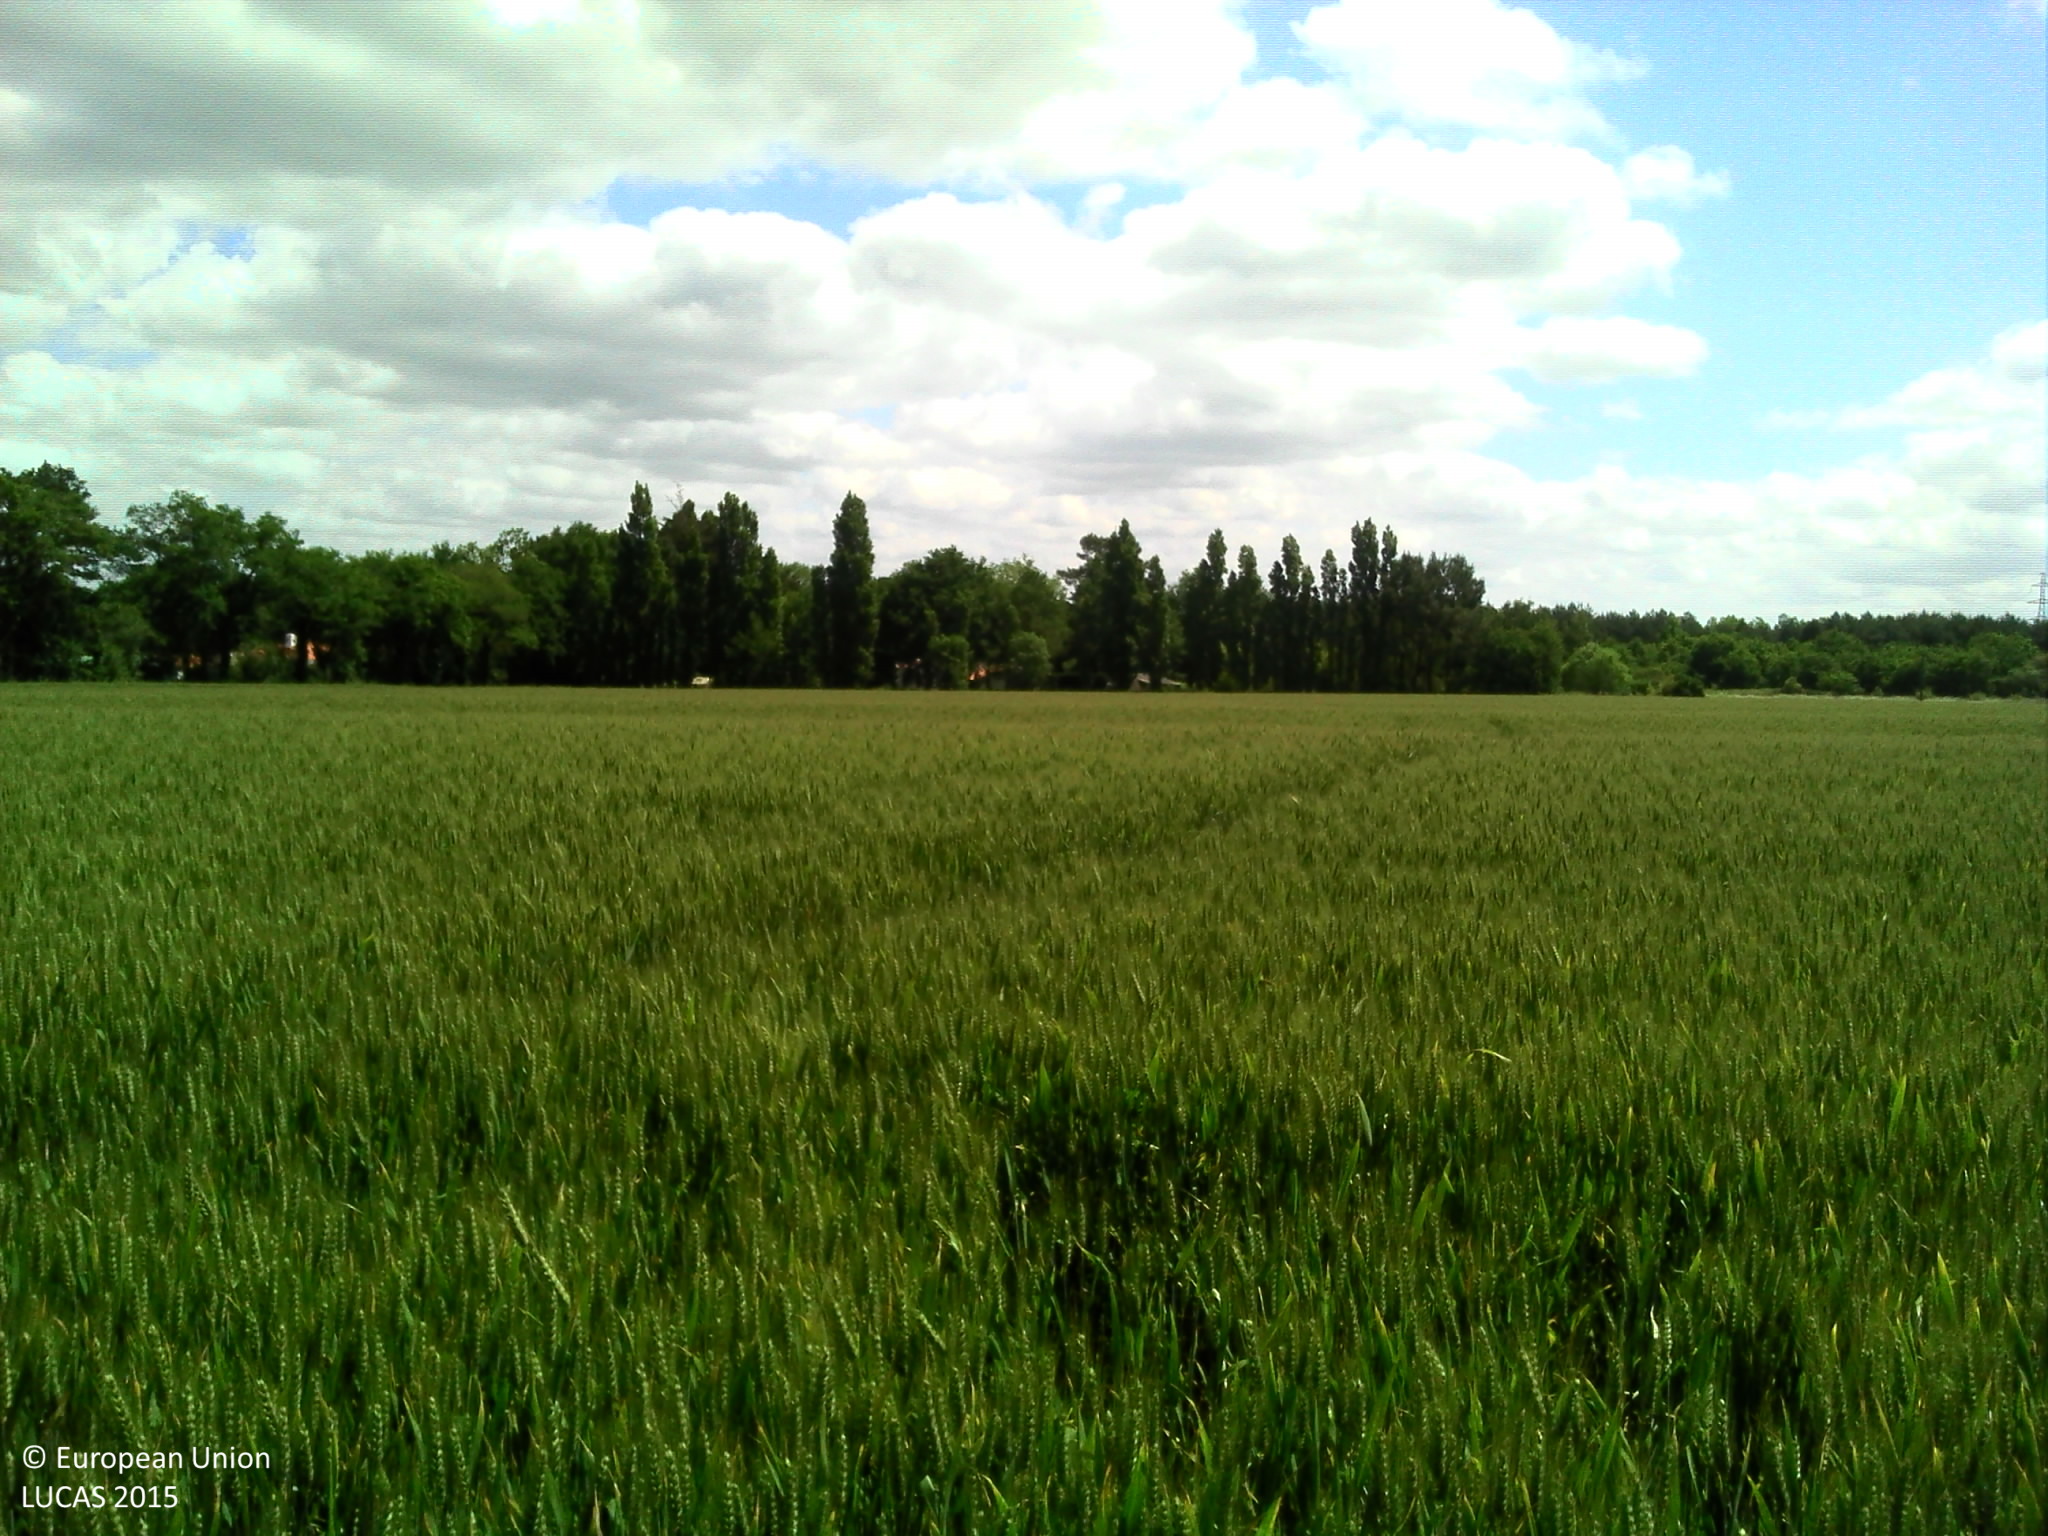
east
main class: Cropland
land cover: Common wheat
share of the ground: > 75 %
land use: Agriculture (excluding fallow land and kitchen gardens)
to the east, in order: Common wheat; Fences; Lines of trees; Artificial constructions in urban areas; Ditches and canals; Grass margins; Paved roads, cycling and walking lanes; Grass margins; Ditches and canals; Fences; Grassland without tree/shrub cover
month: June
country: FR
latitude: 46.9154
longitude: -1.9553
